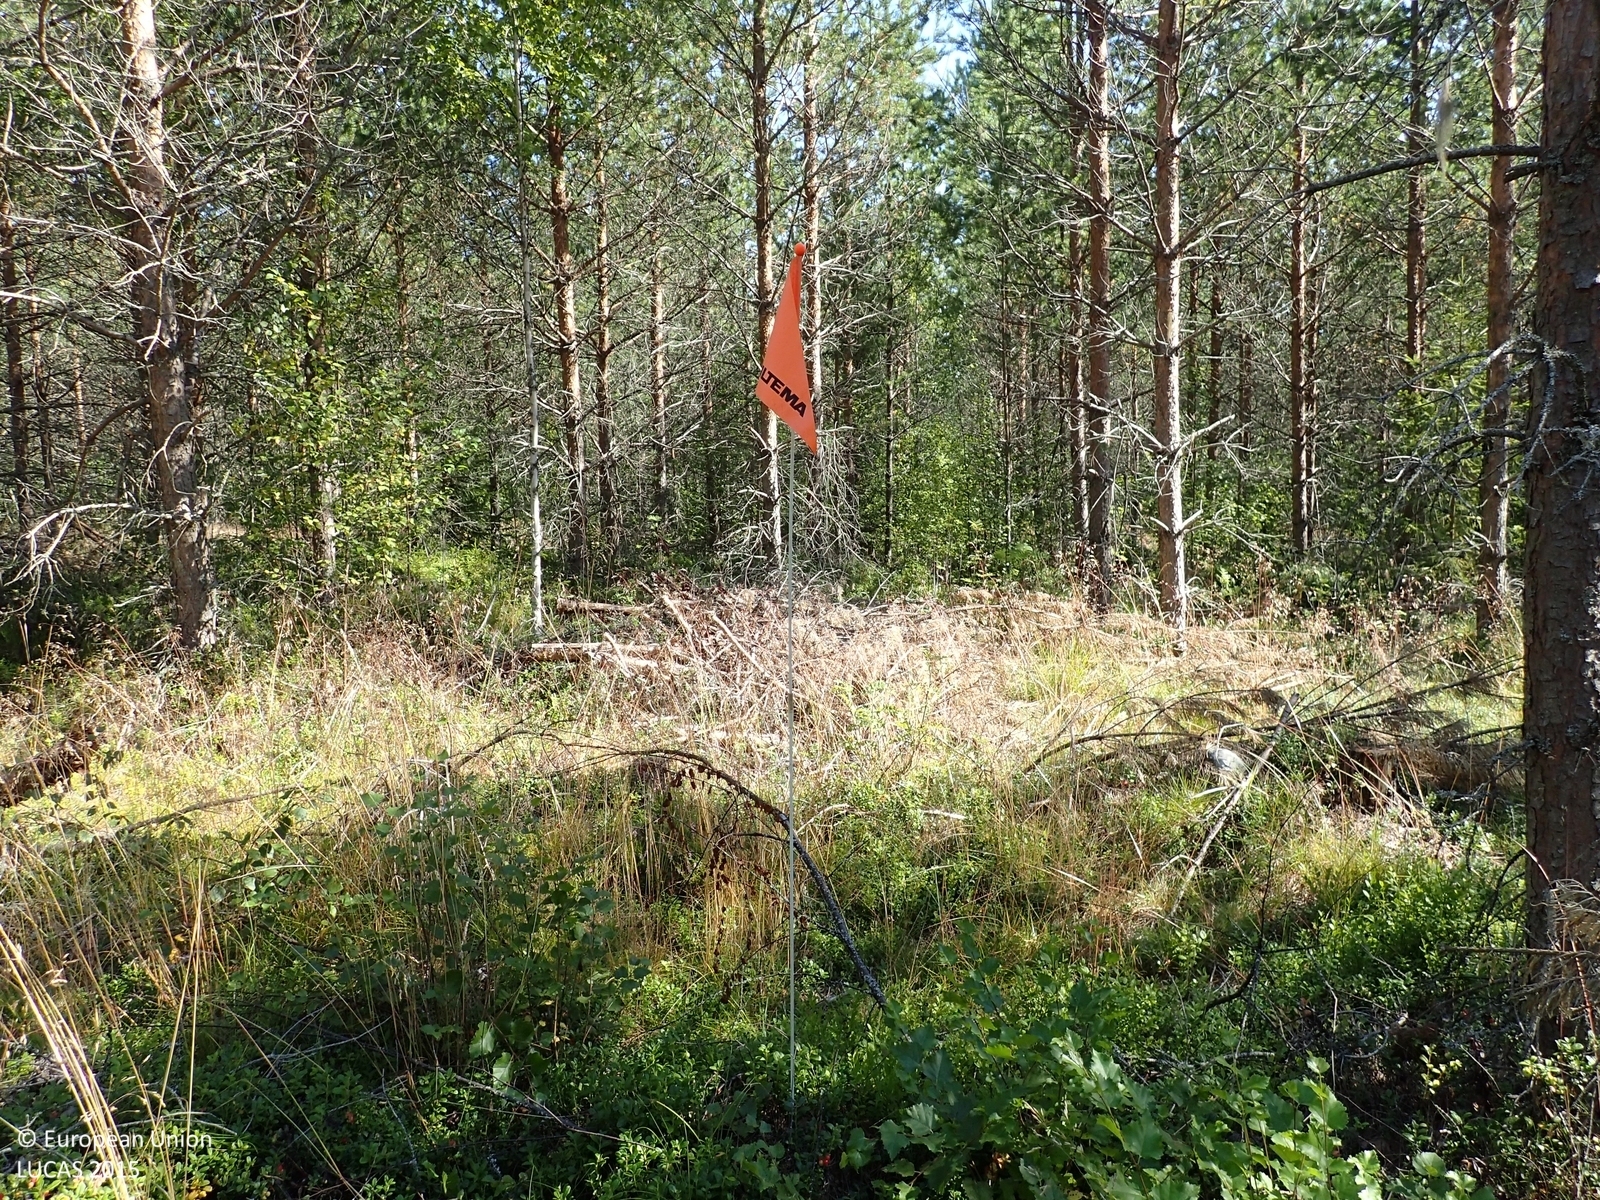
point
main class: Woodland
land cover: Pine dominated coniferous woodland
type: boreal forest
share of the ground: > 75 %
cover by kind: coniferous forest trees 75 %, shrubs 15 %, broadleaved forest trees 5 %, herbaceous plants 5 %
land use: Forestry
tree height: < 5 m
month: August
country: FI
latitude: 62.5331
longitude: 21.7648
